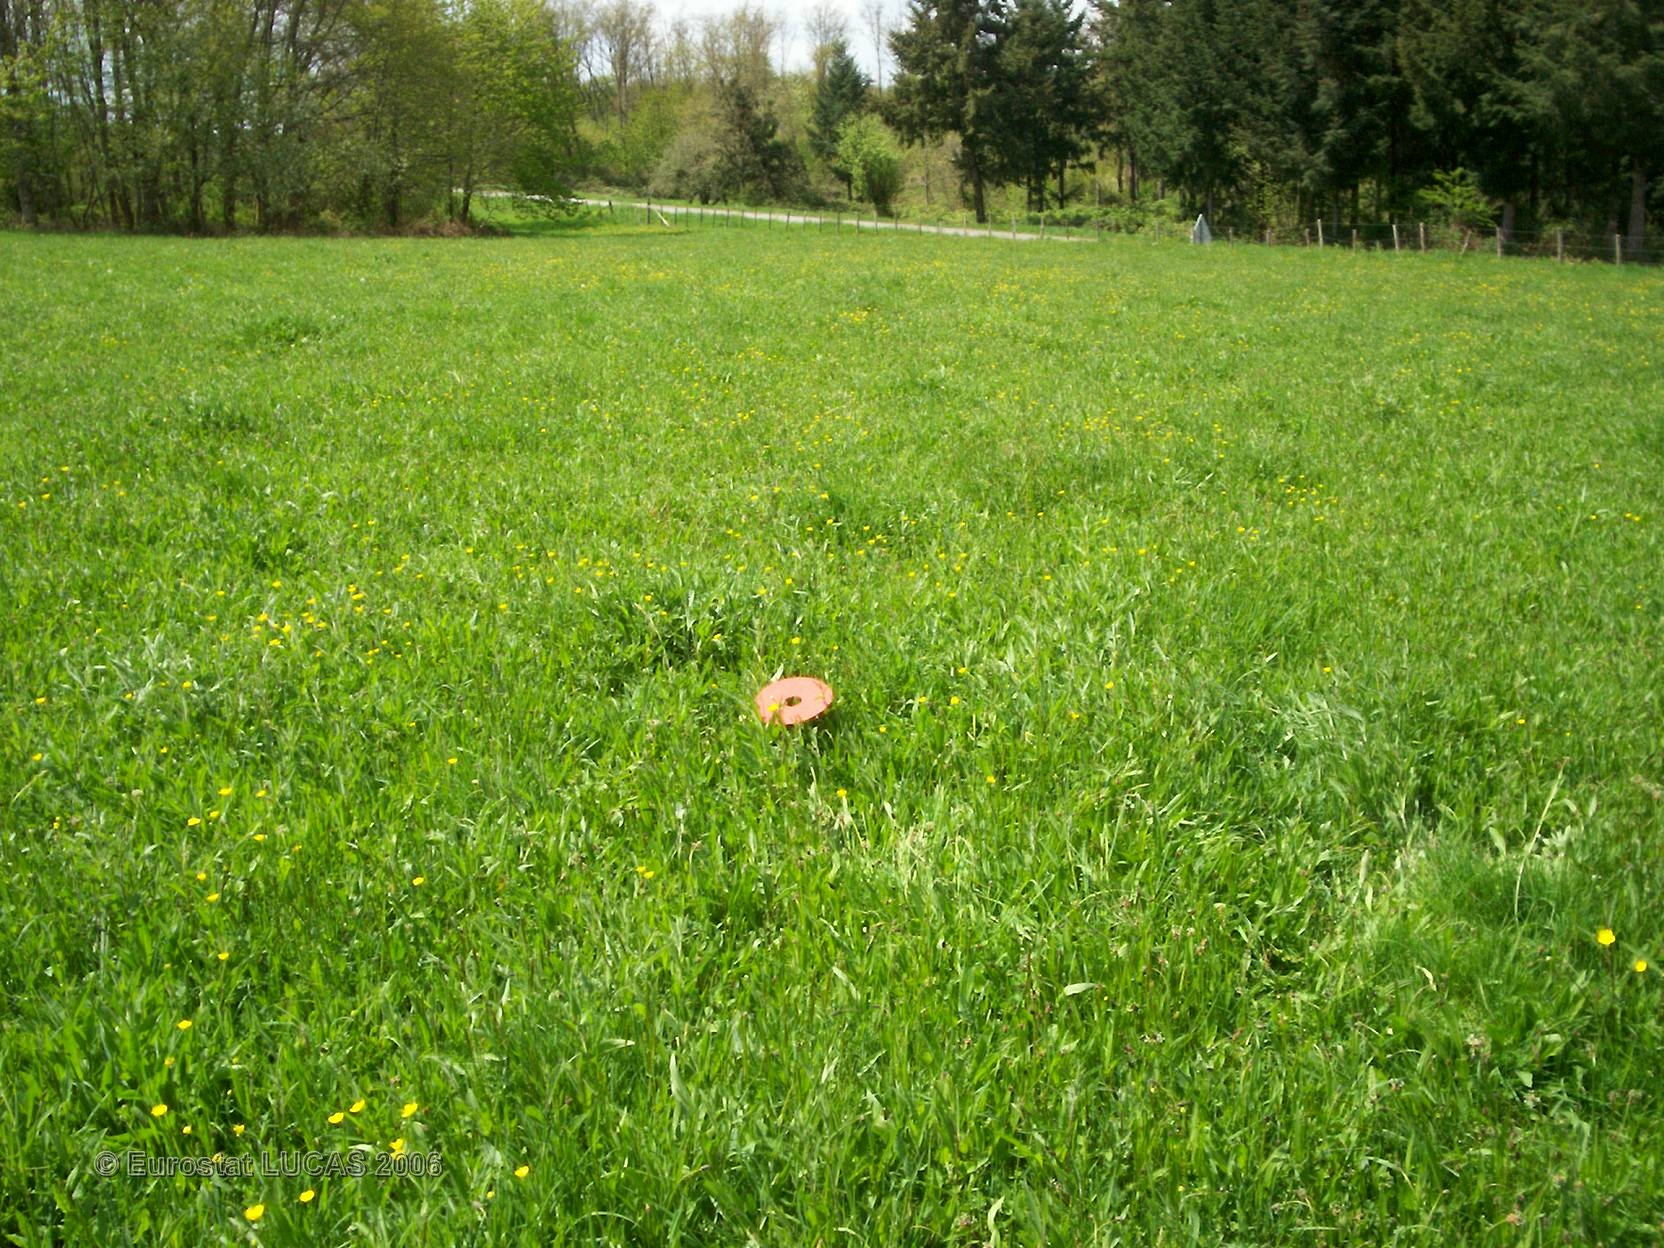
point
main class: Grassland
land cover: Grassland without tree/shrub cover
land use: Agriculture (excluding fallow land and kitchen gardens)
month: April
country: FR
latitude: 45.6448
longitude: 0.5822
